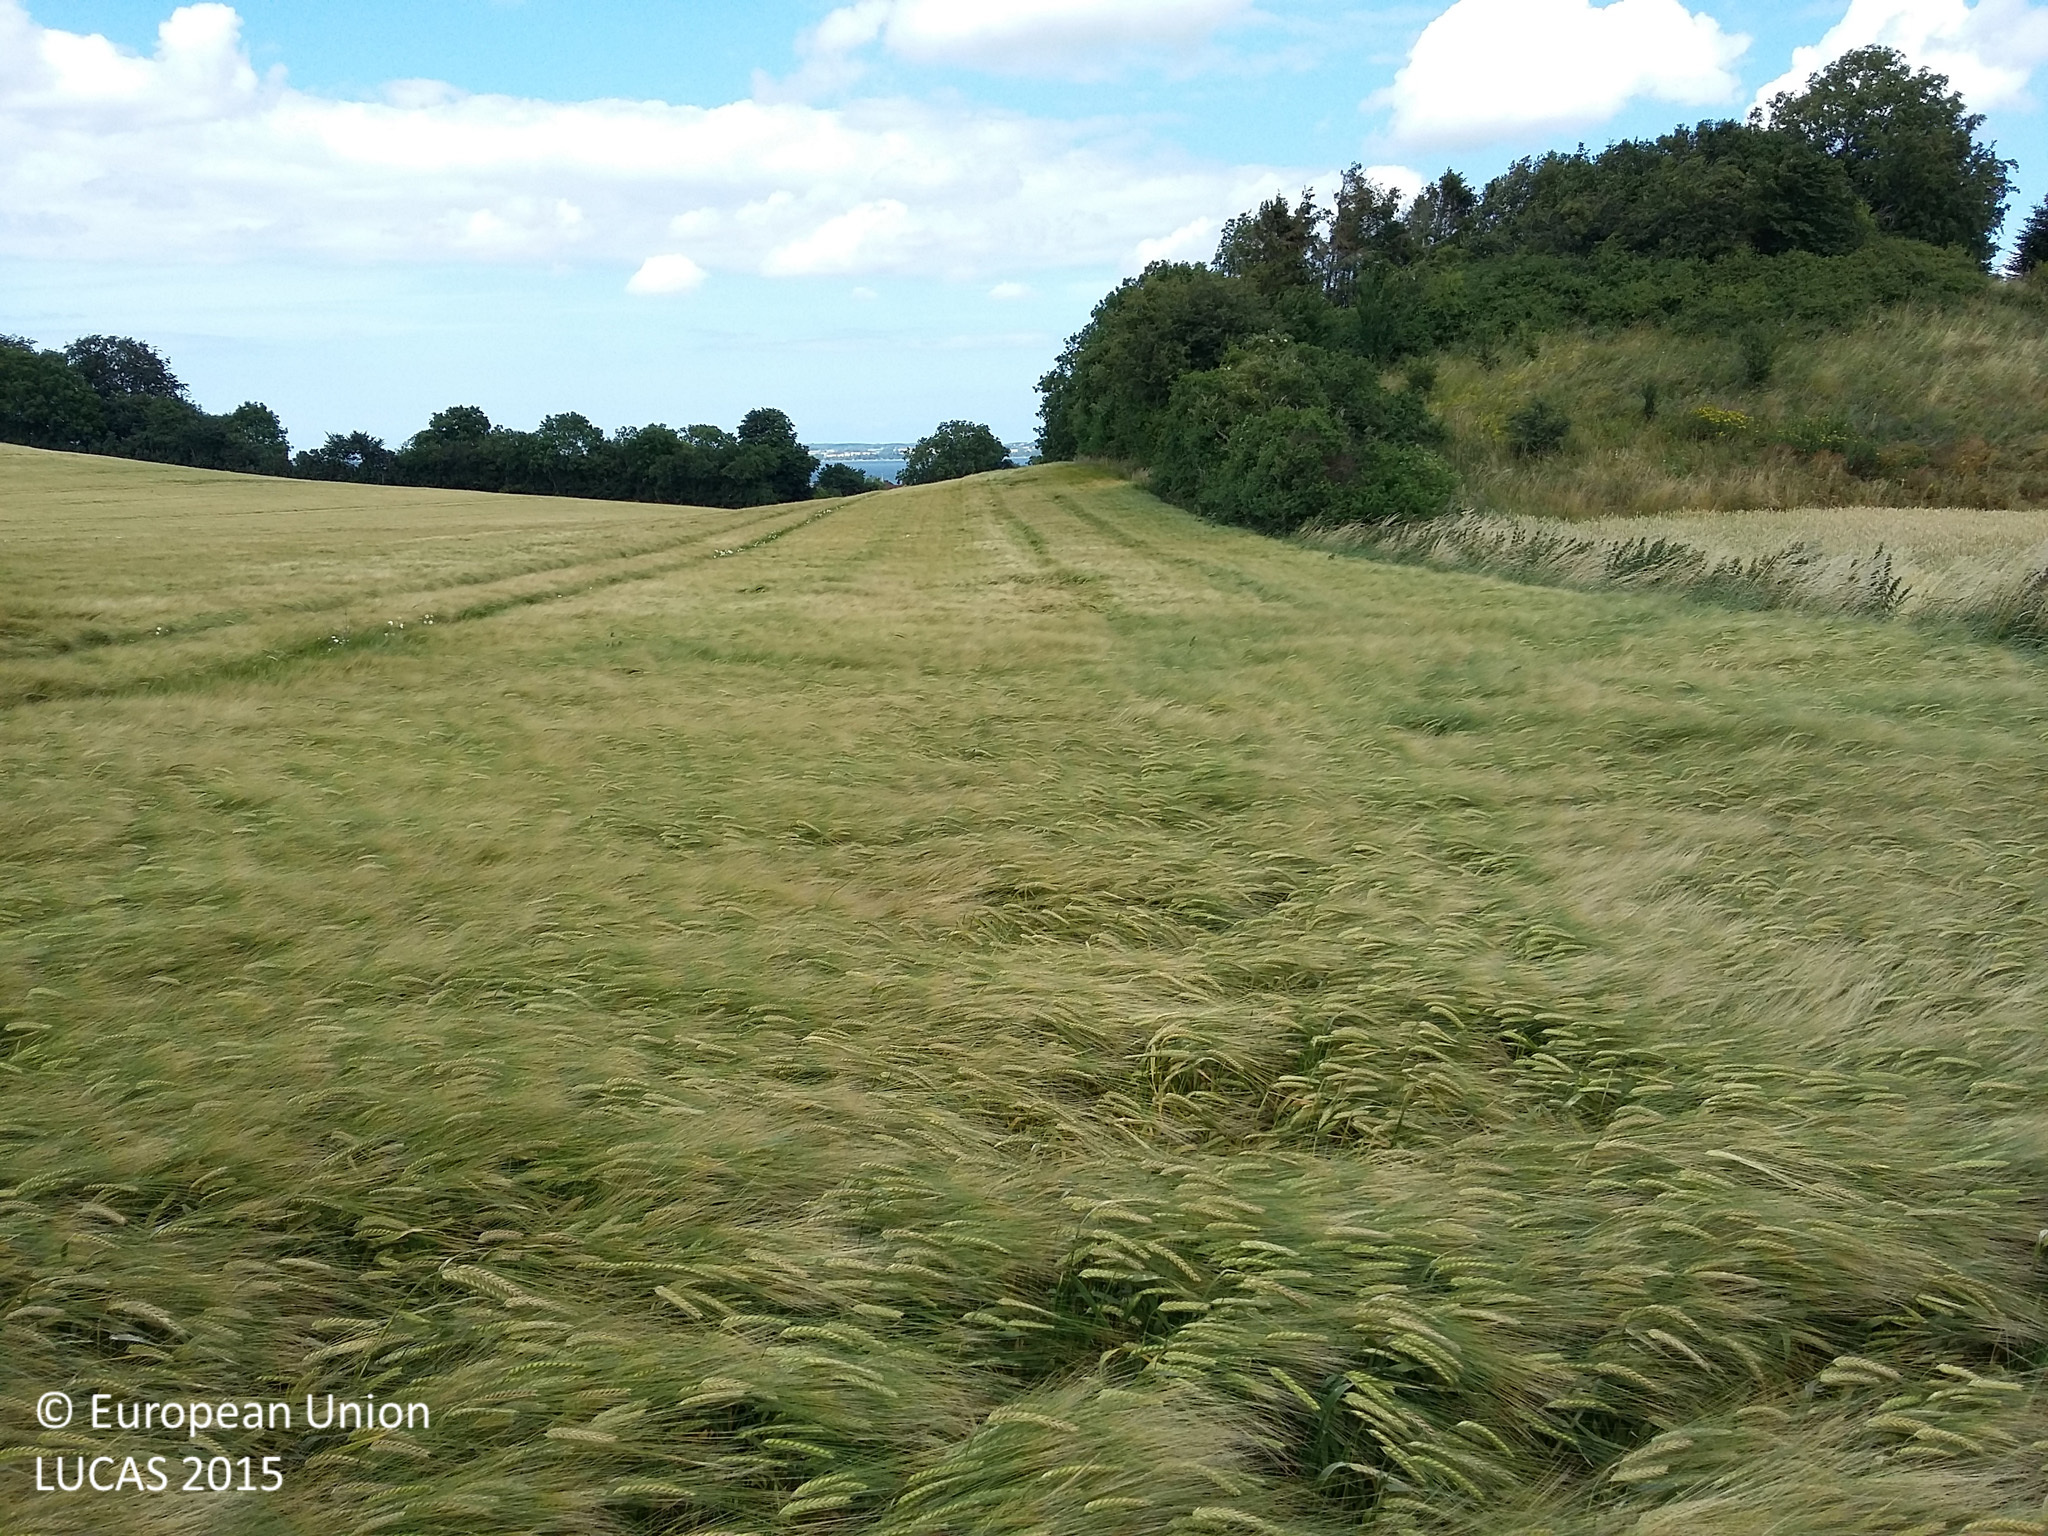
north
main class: Cropland
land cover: Barley
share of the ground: > 75 %
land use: Agriculture (excluding fallow land and kitchen gardens)
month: July
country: DK
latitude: 55.7634
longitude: 11.6718
